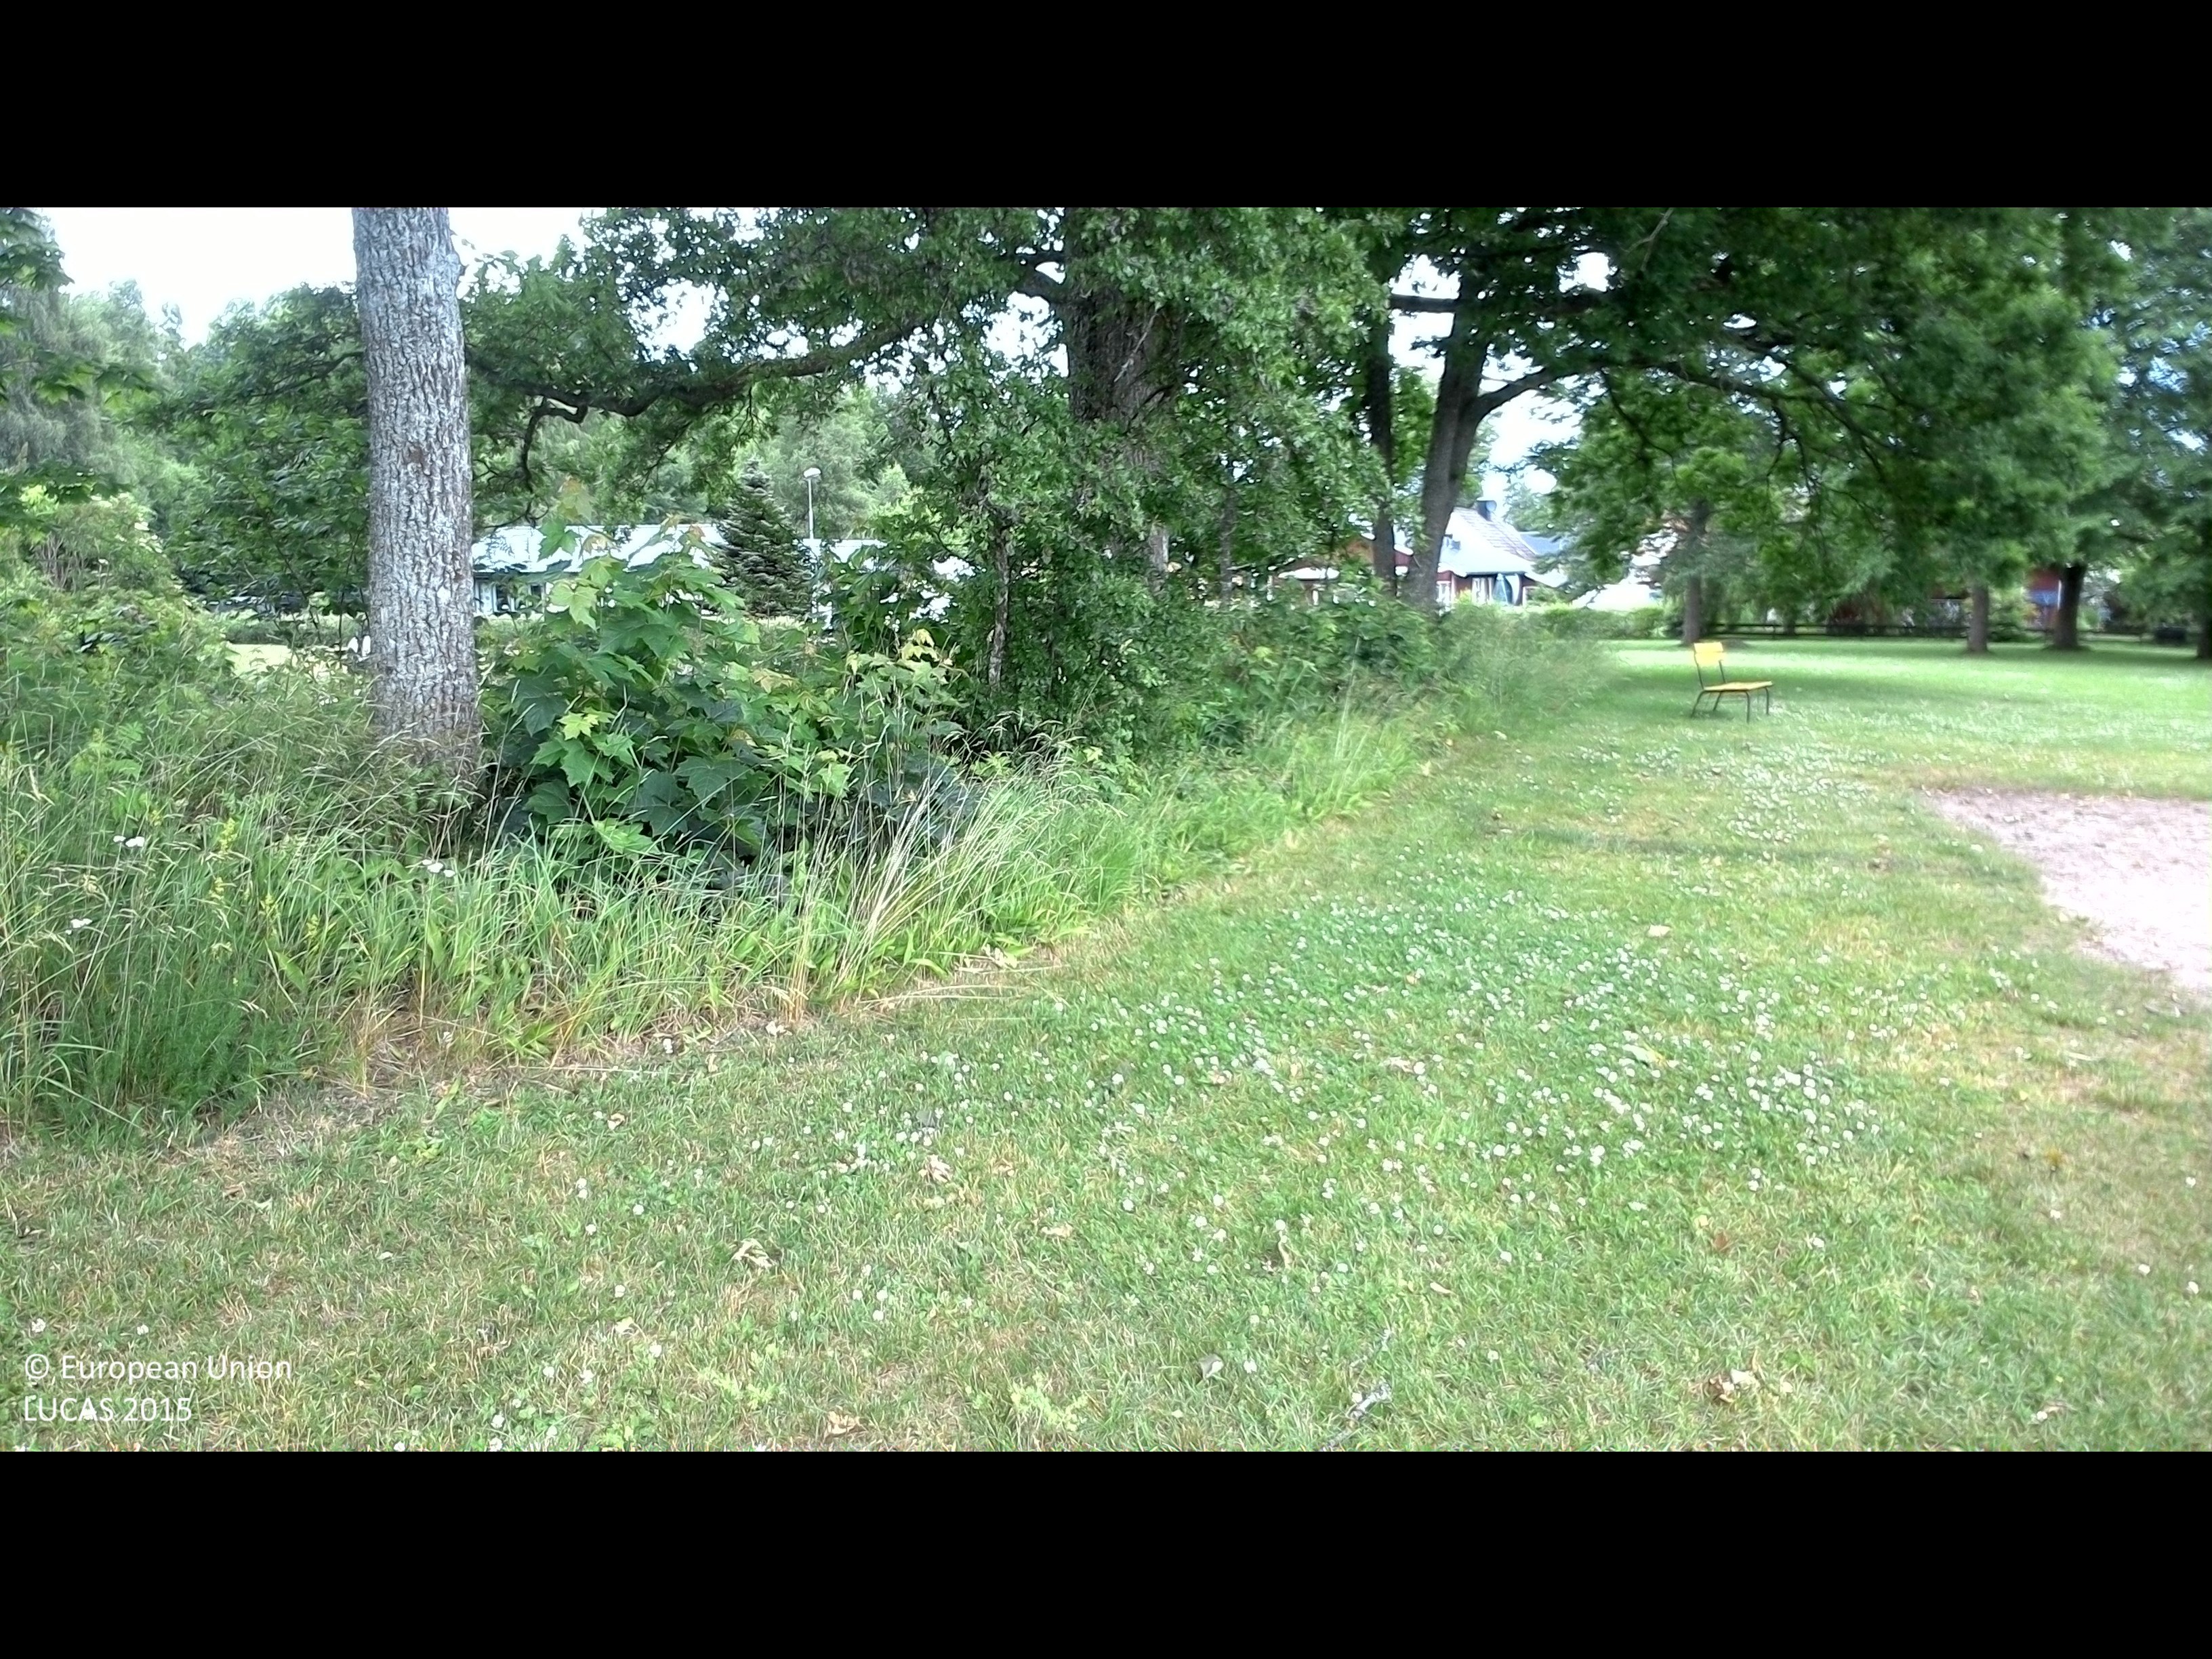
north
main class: Grassland
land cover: Grassland without tree/shrub cover
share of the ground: > 75 %
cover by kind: herbaceous plants 100 %
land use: Amenities, museums, leisure
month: July
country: SE
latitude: 56.4624
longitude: 14.6880
